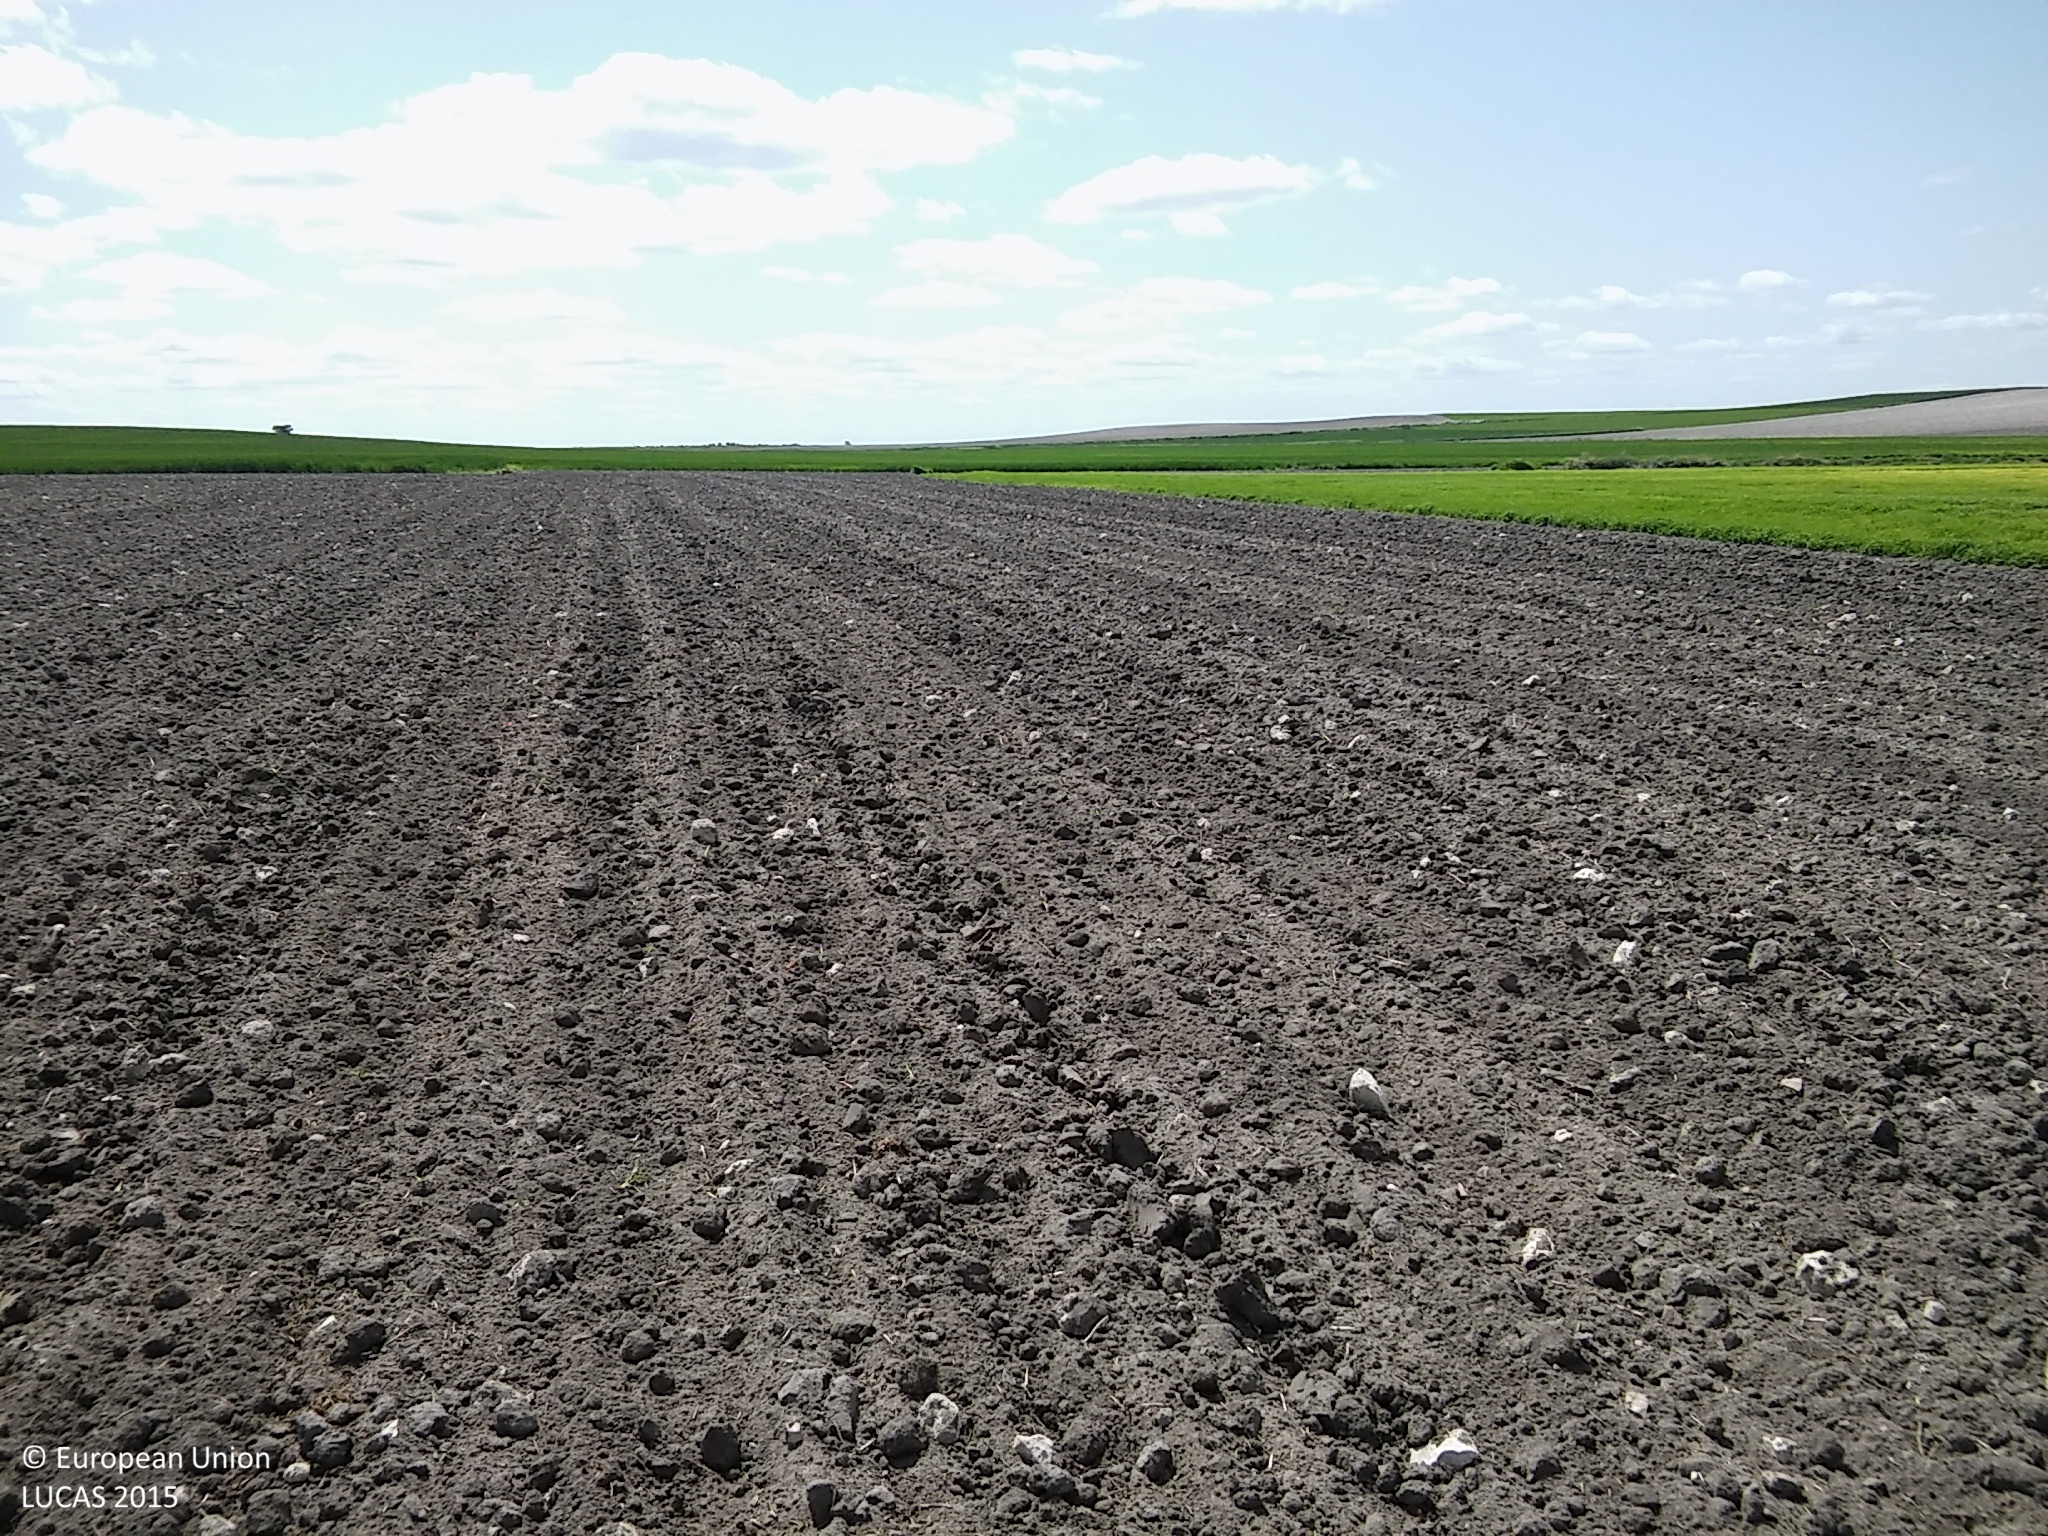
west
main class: Cropland
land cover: Sunflower
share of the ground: < 10 %
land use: Agriculture (excluding fallow land and kitchen gardens)
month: May
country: ES
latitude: 41.3864
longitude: -4.1070
